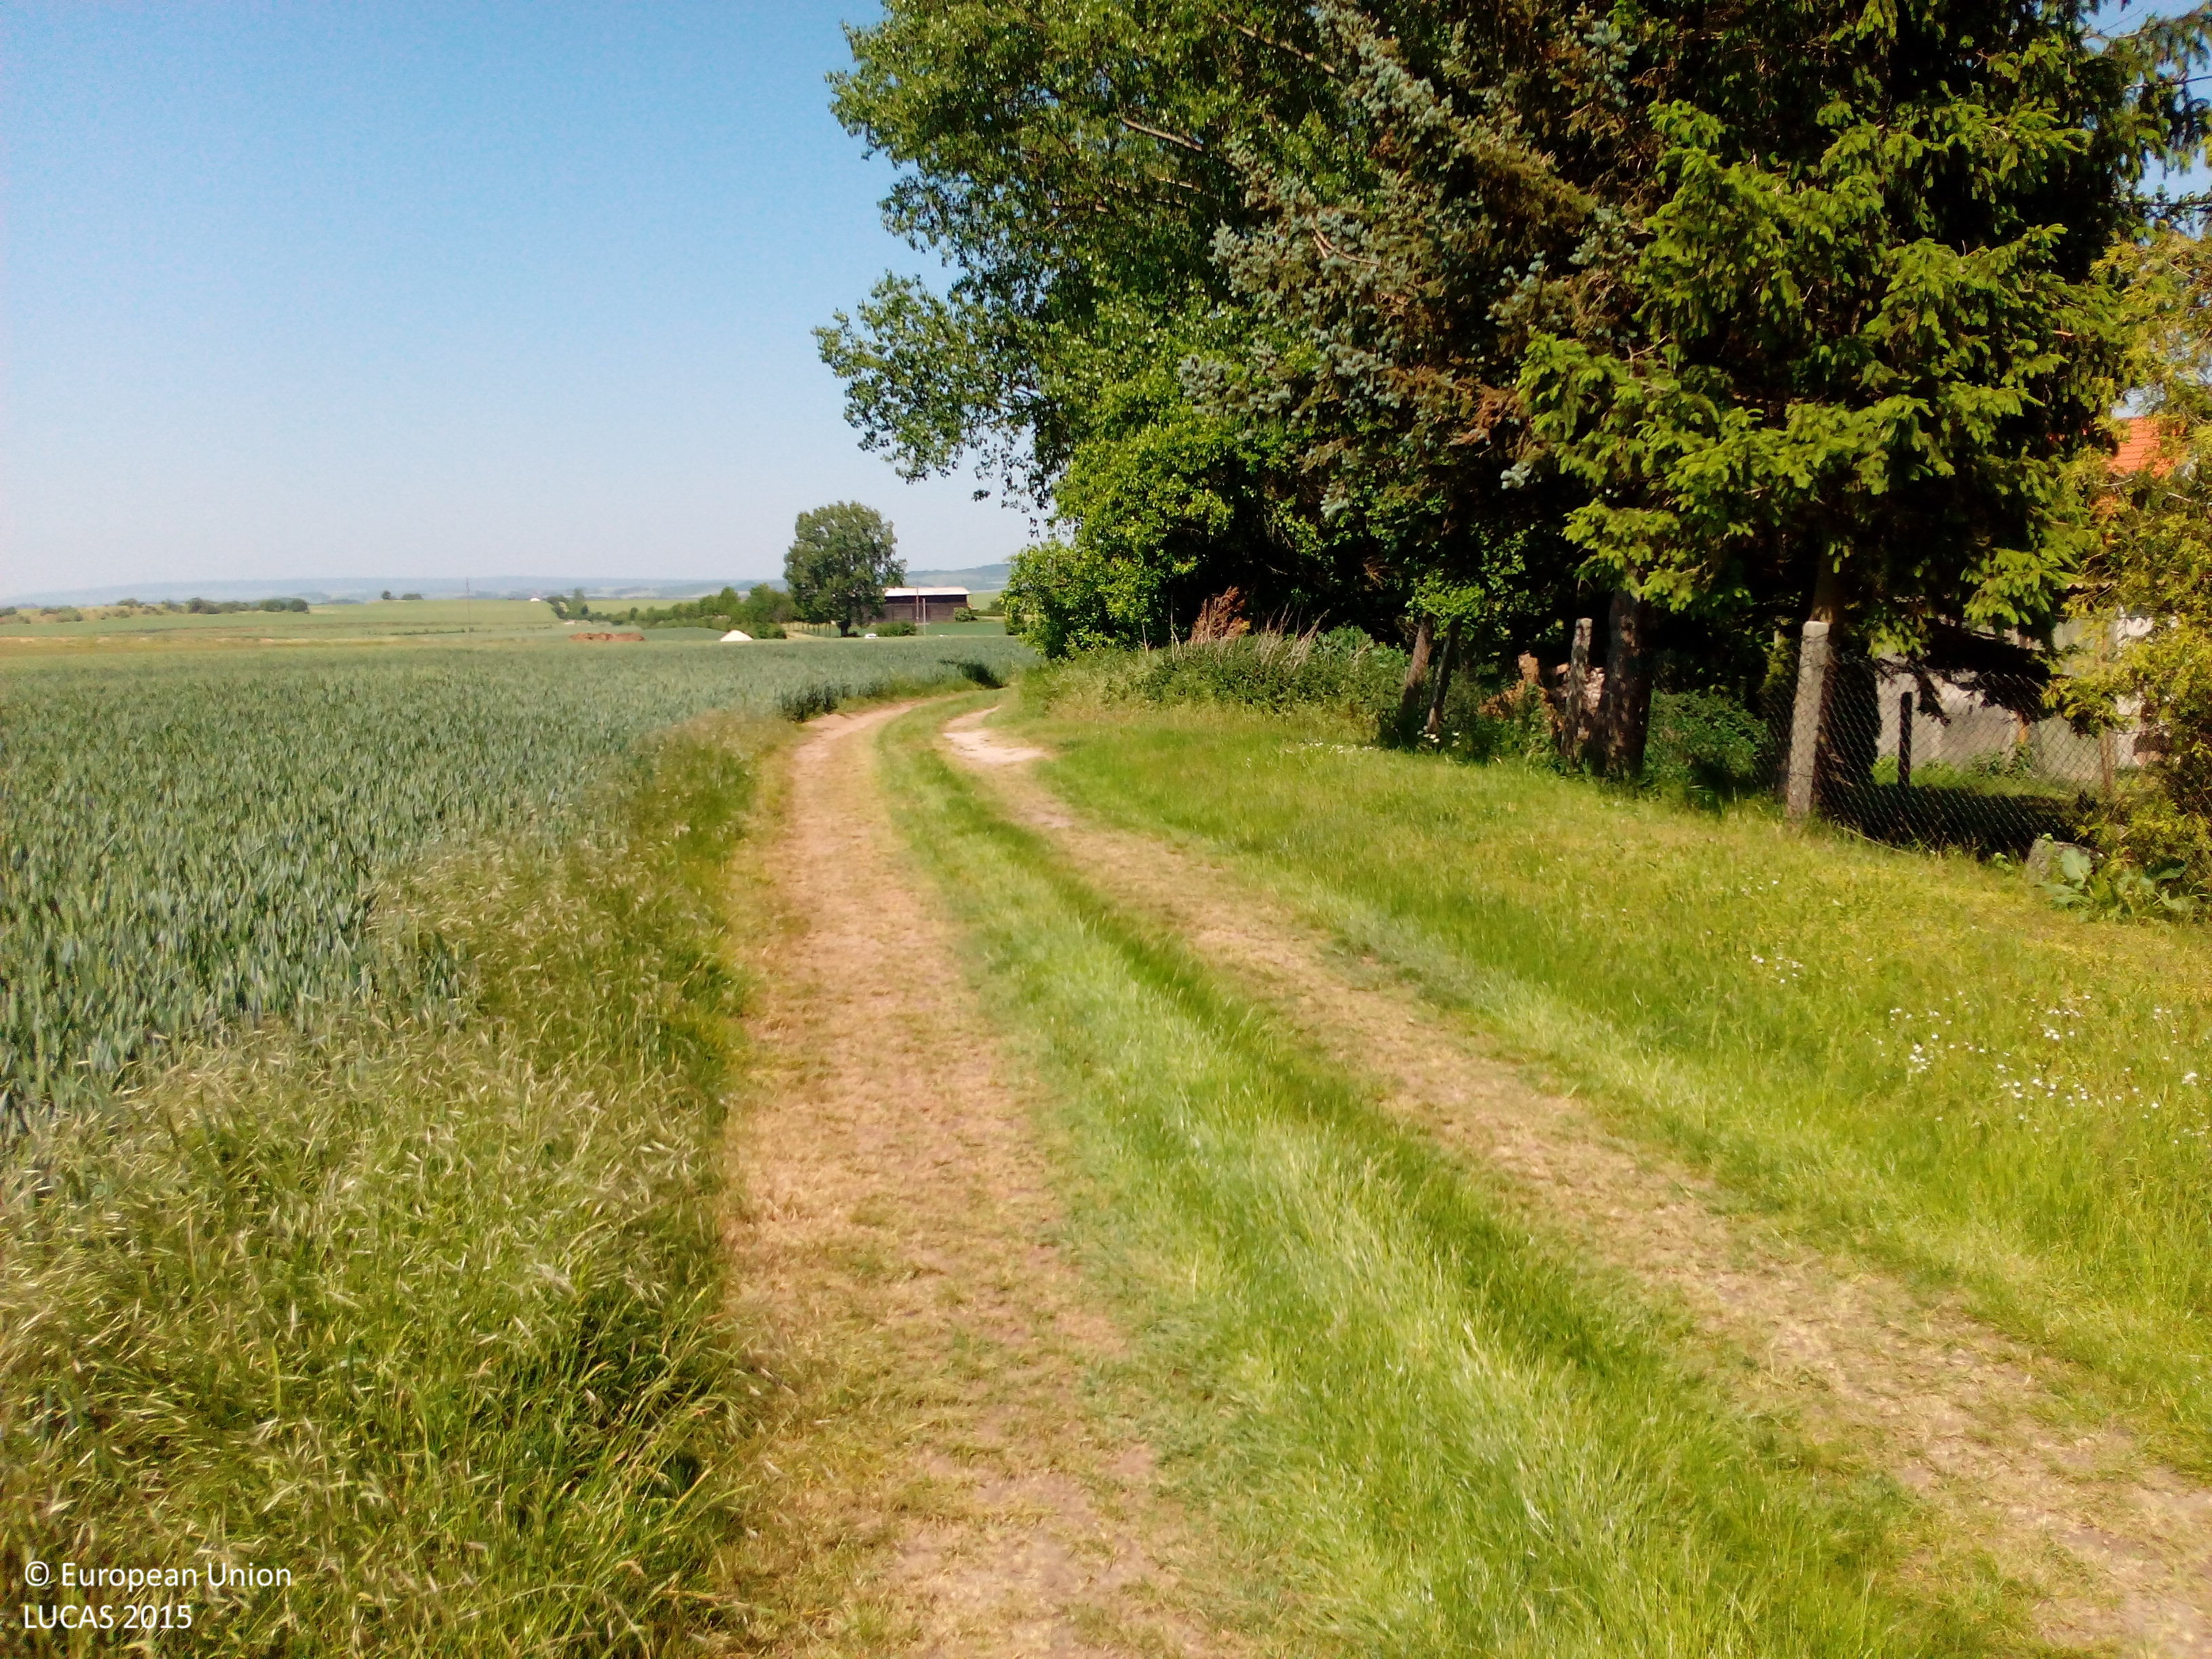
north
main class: Cropland
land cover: Common wheat
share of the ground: > 75 %
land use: Agriculture (excluding fallow land and kitchen gardens)
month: June
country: DE
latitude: 52.0149
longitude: 10.8594
